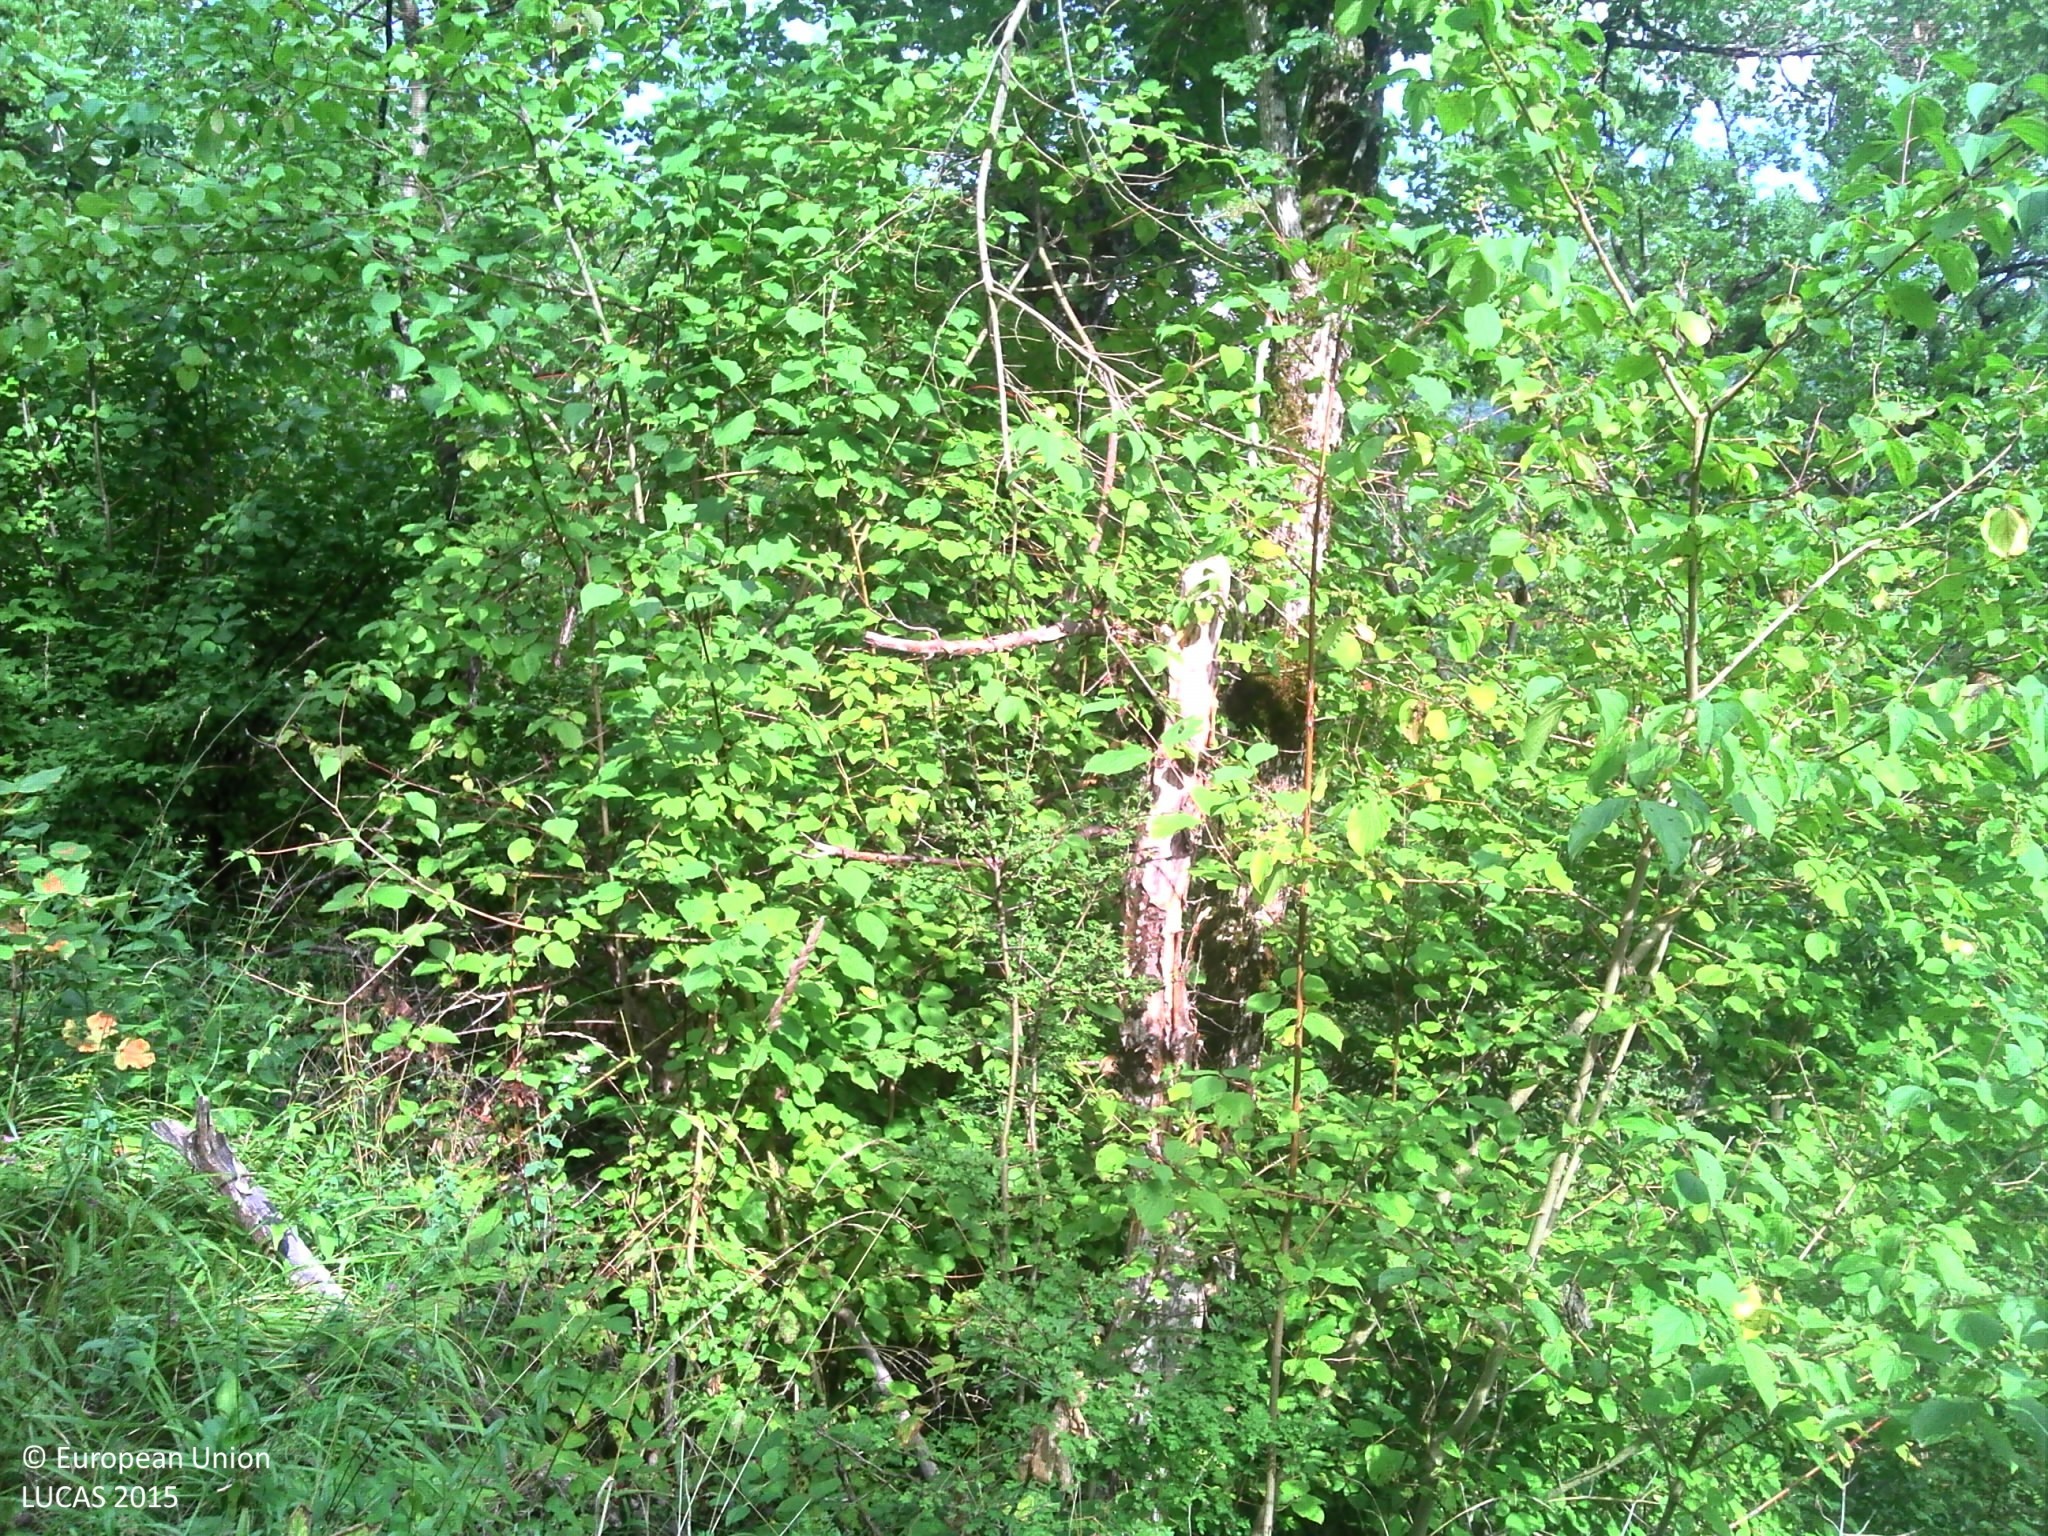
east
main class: Woodland
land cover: Broadleaved woodland
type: mesophytic deciduous forest
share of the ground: > 75 %
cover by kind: broadleaved forest trees 80 %, unconsolidated bare surface 10 %, coniferous forest trees 5 %, lichens and mosses 5 %
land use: Forestry
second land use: Sport
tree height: > 5 m
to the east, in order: Broadleaved woodland; Electric lines; Broadleaved woodland; Tracks; Rock outcrops; Tracks; Broadleaved woodland
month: August
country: FR
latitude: 45.2676
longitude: 5.5826
